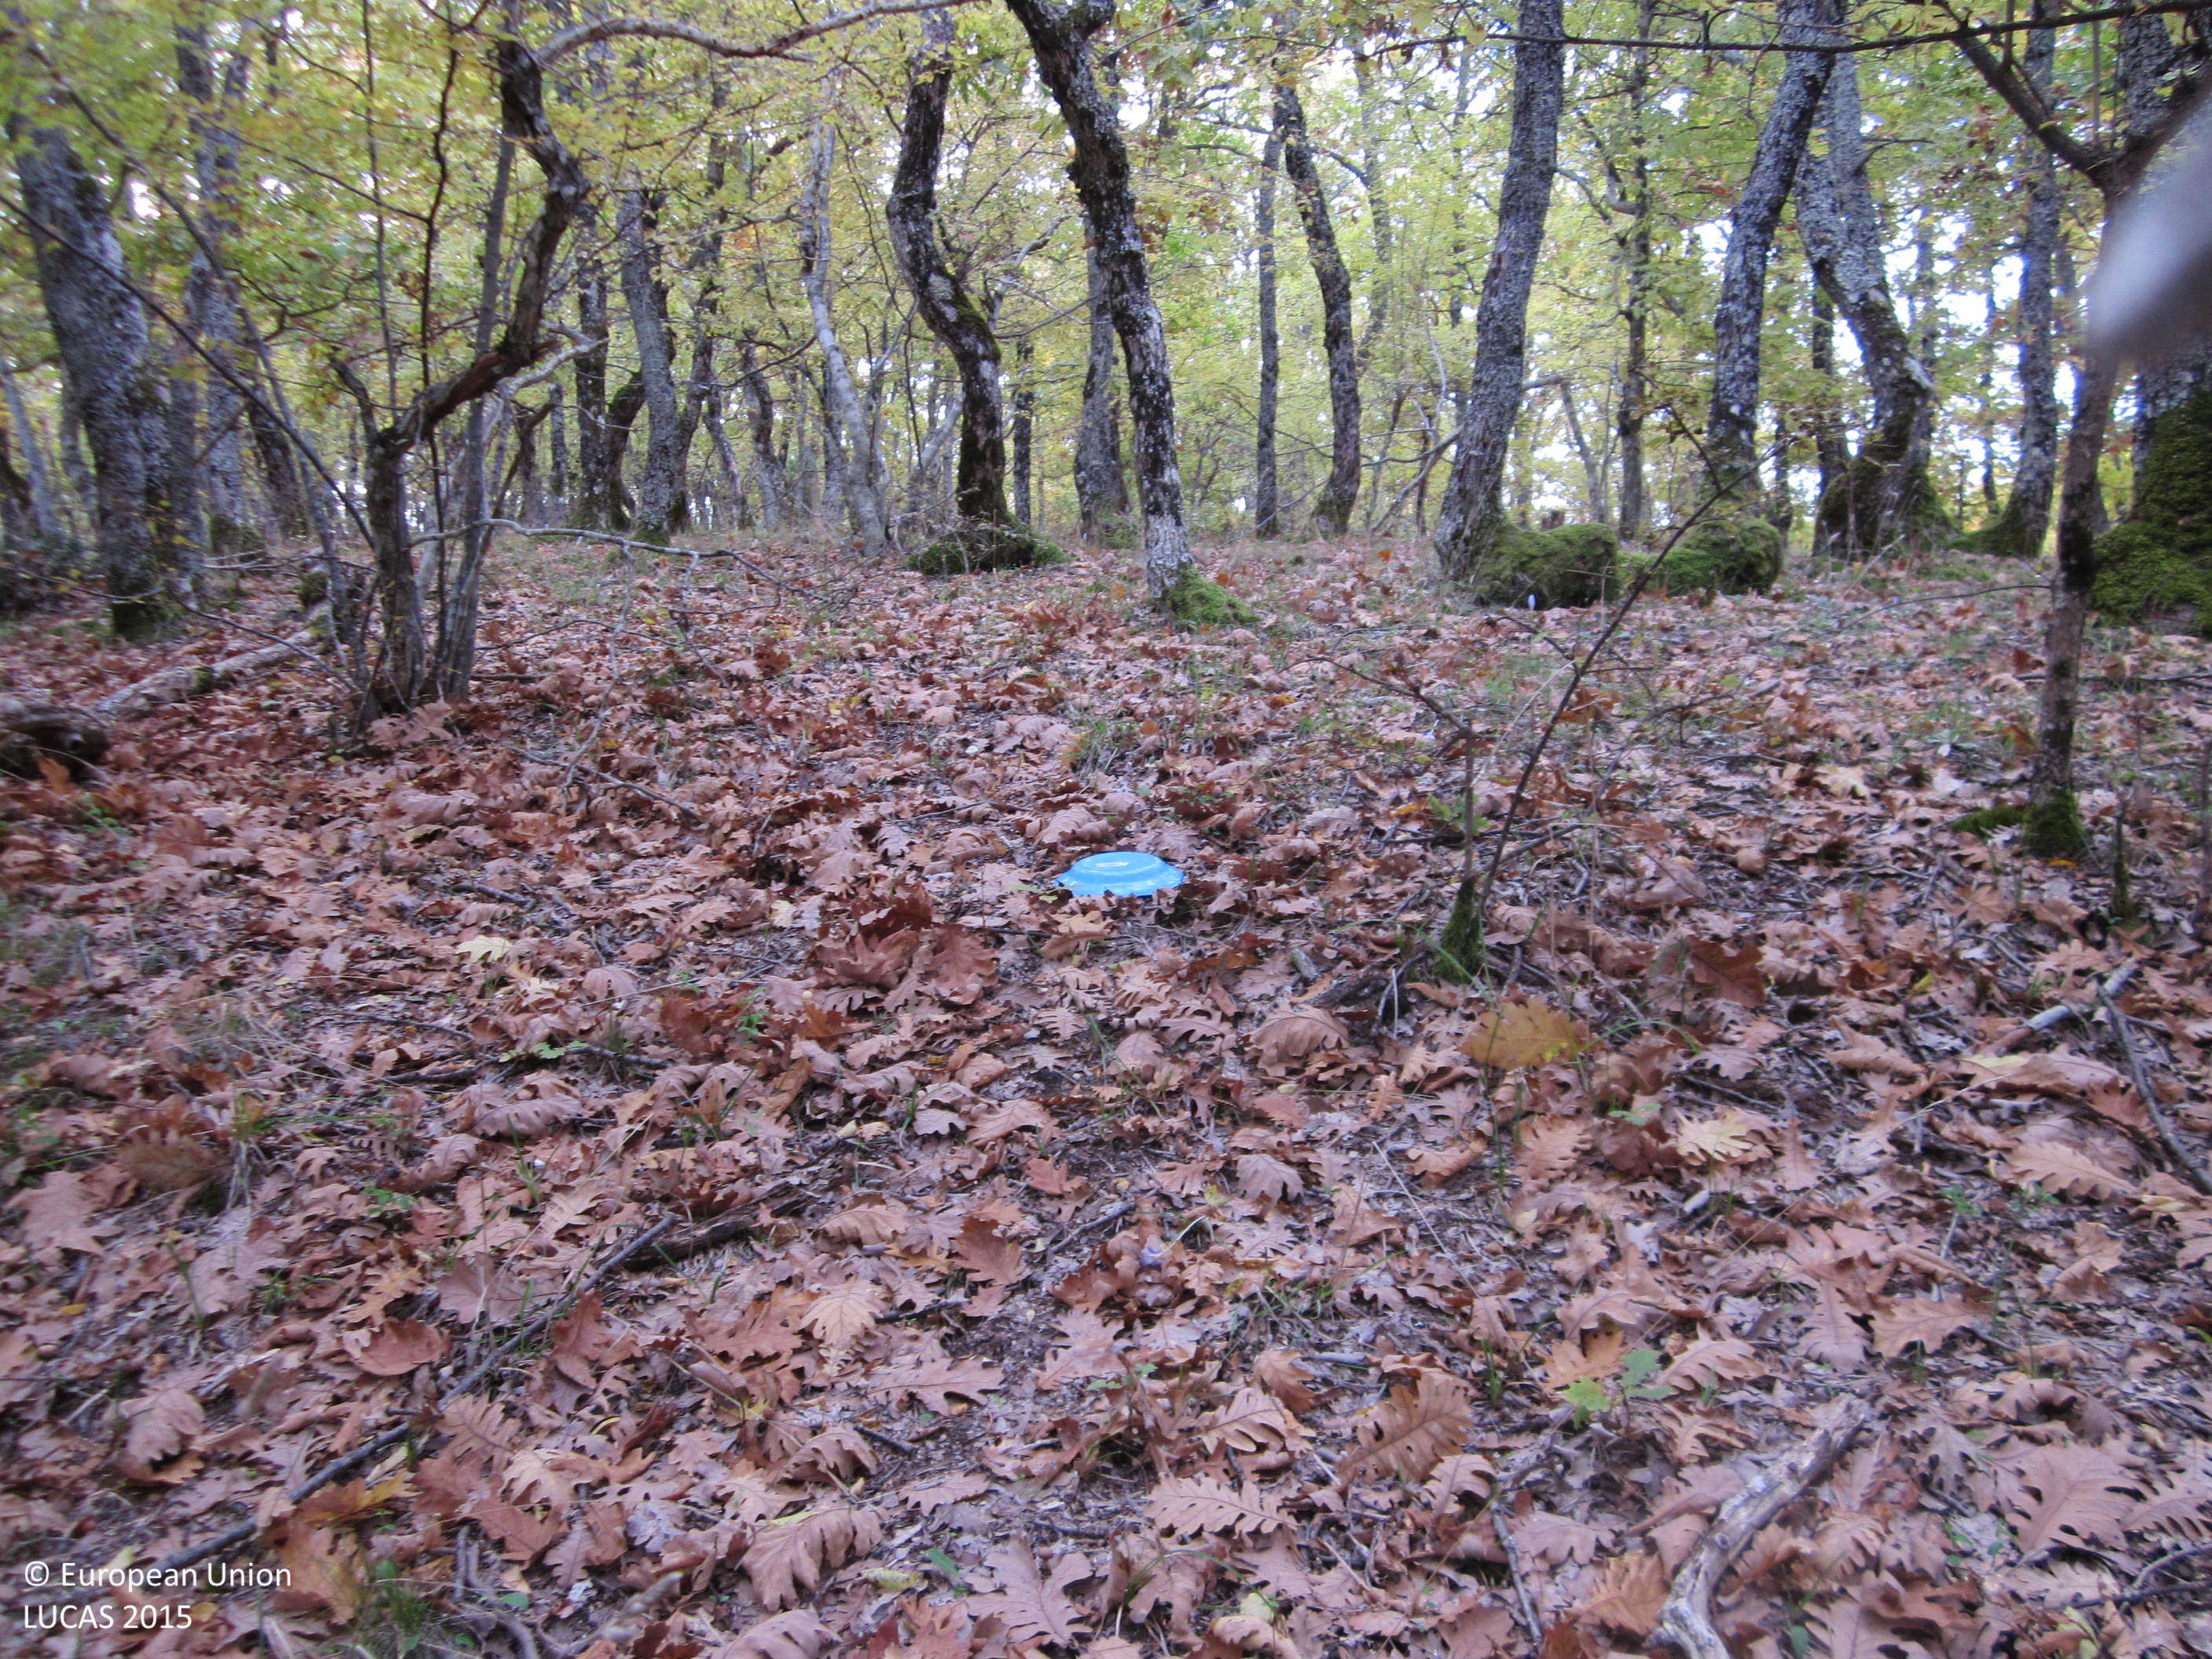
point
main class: Woodland
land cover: Broadleaved woodland
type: mesophytic deciduous forest
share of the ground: > 75 %
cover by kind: broadleaved forest trees 85 %, unconsolidated bare surface 10 %, lichens and mosses 5 %
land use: Forestry
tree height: > 5 m
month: November
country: BG
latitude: 41.4614
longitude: 25.9047
